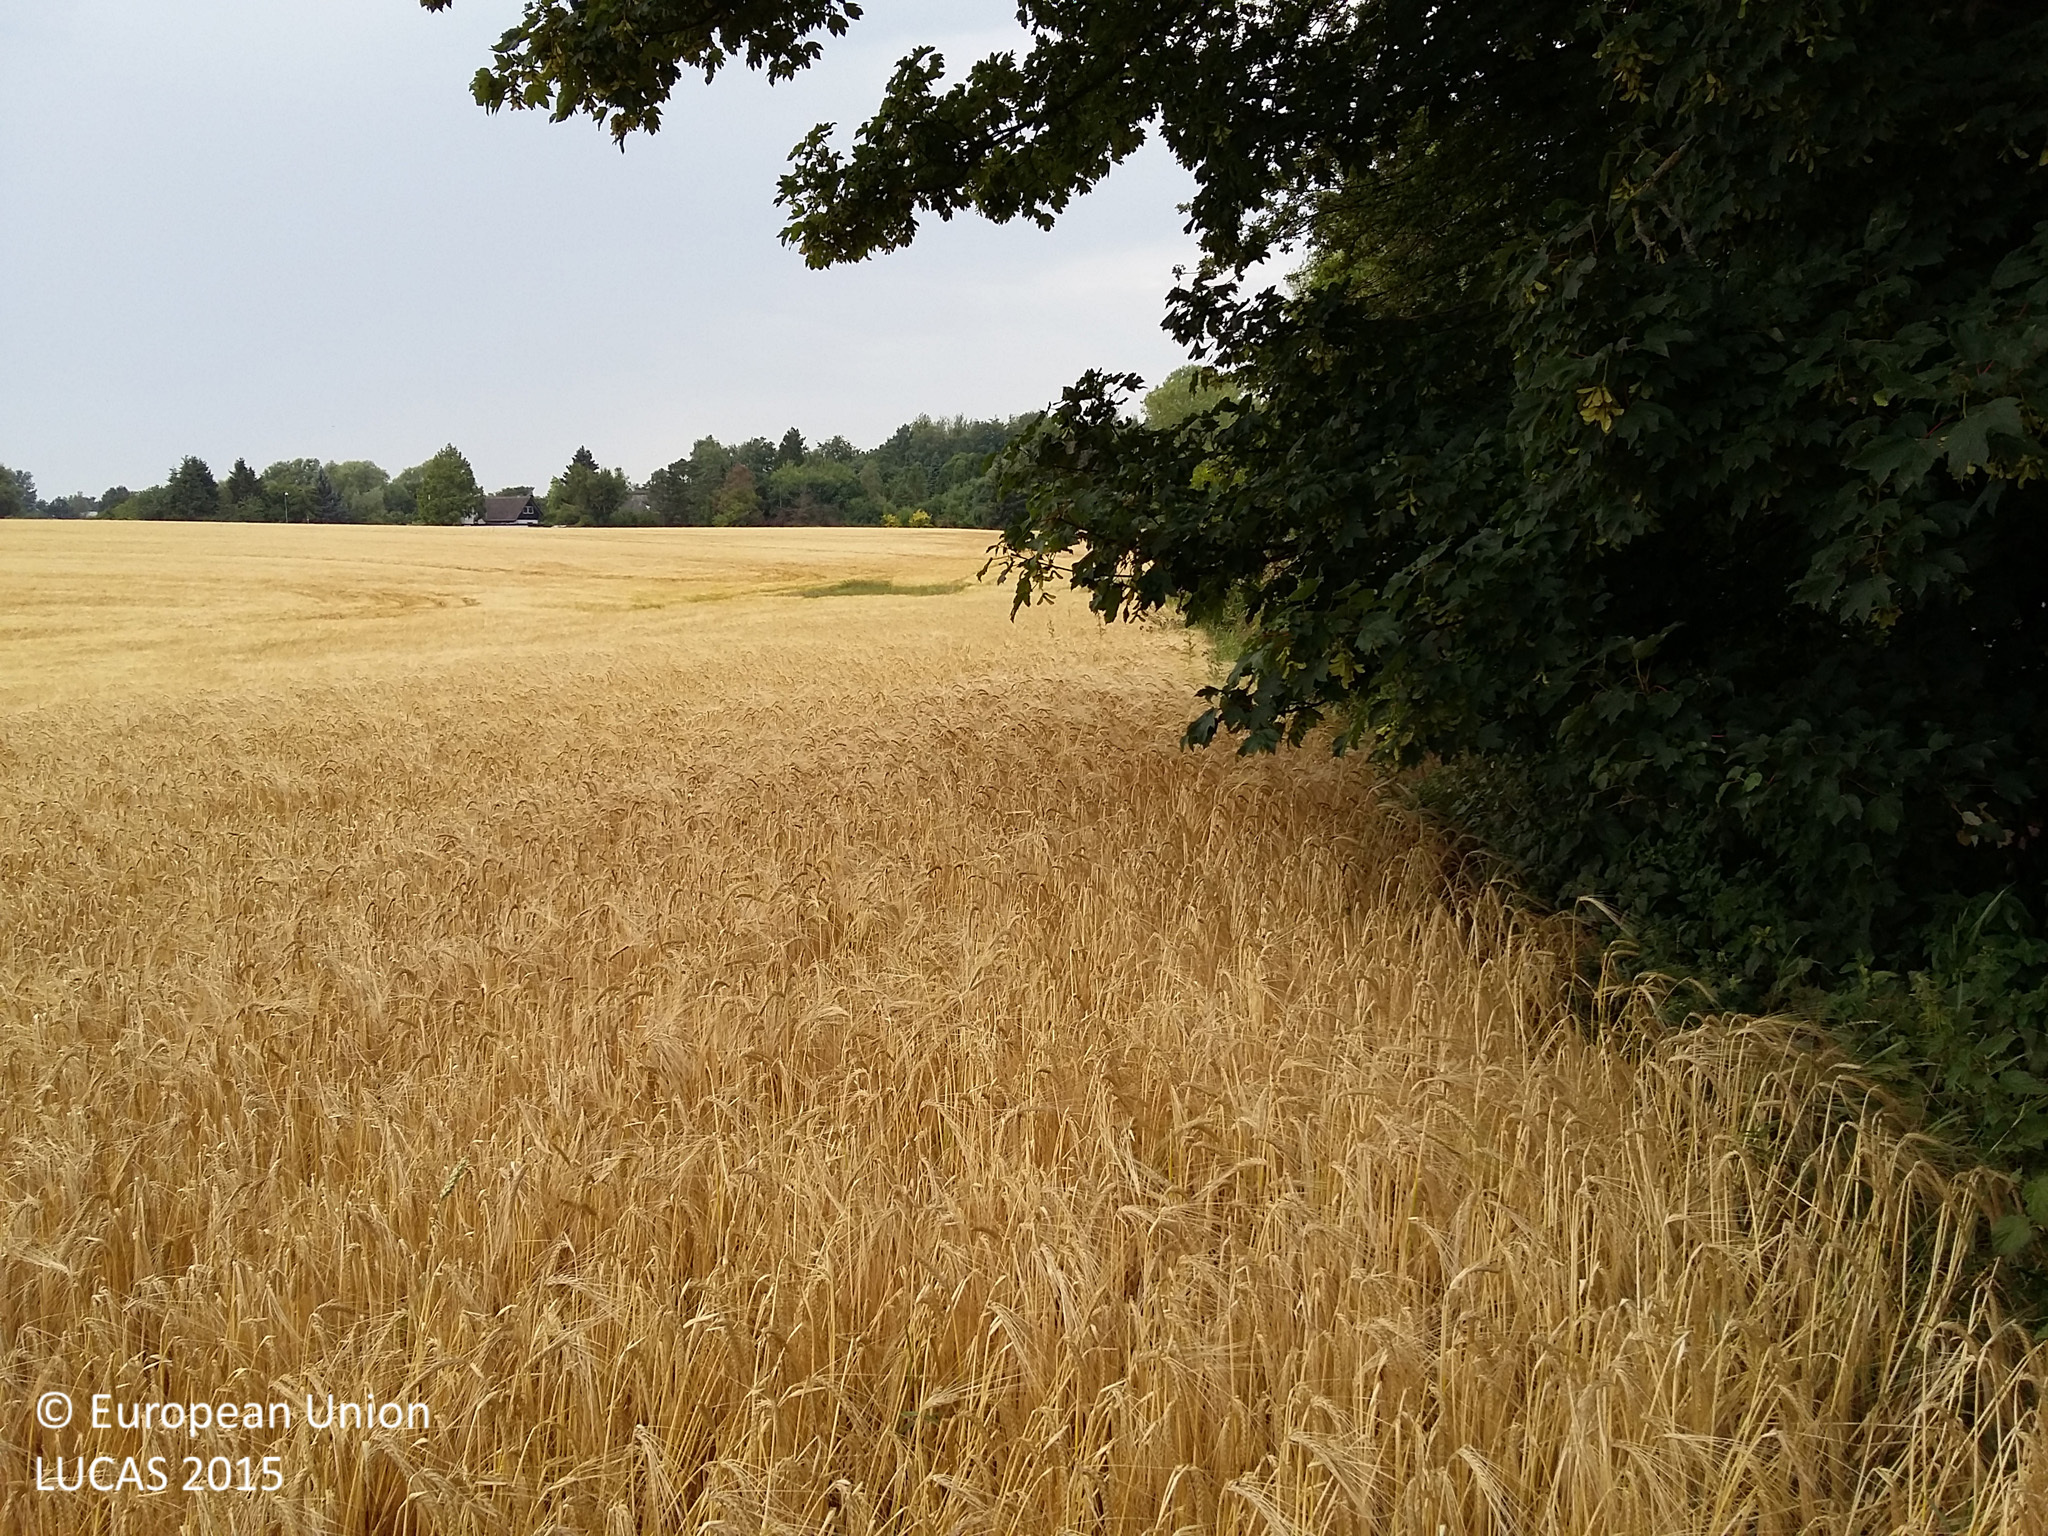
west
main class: Cropland
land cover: Barley
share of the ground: > 75 %
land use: Agriculture (excluding fallow land and kitchen gardens)
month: August
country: DK
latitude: 55.4143
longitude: 12.1624
